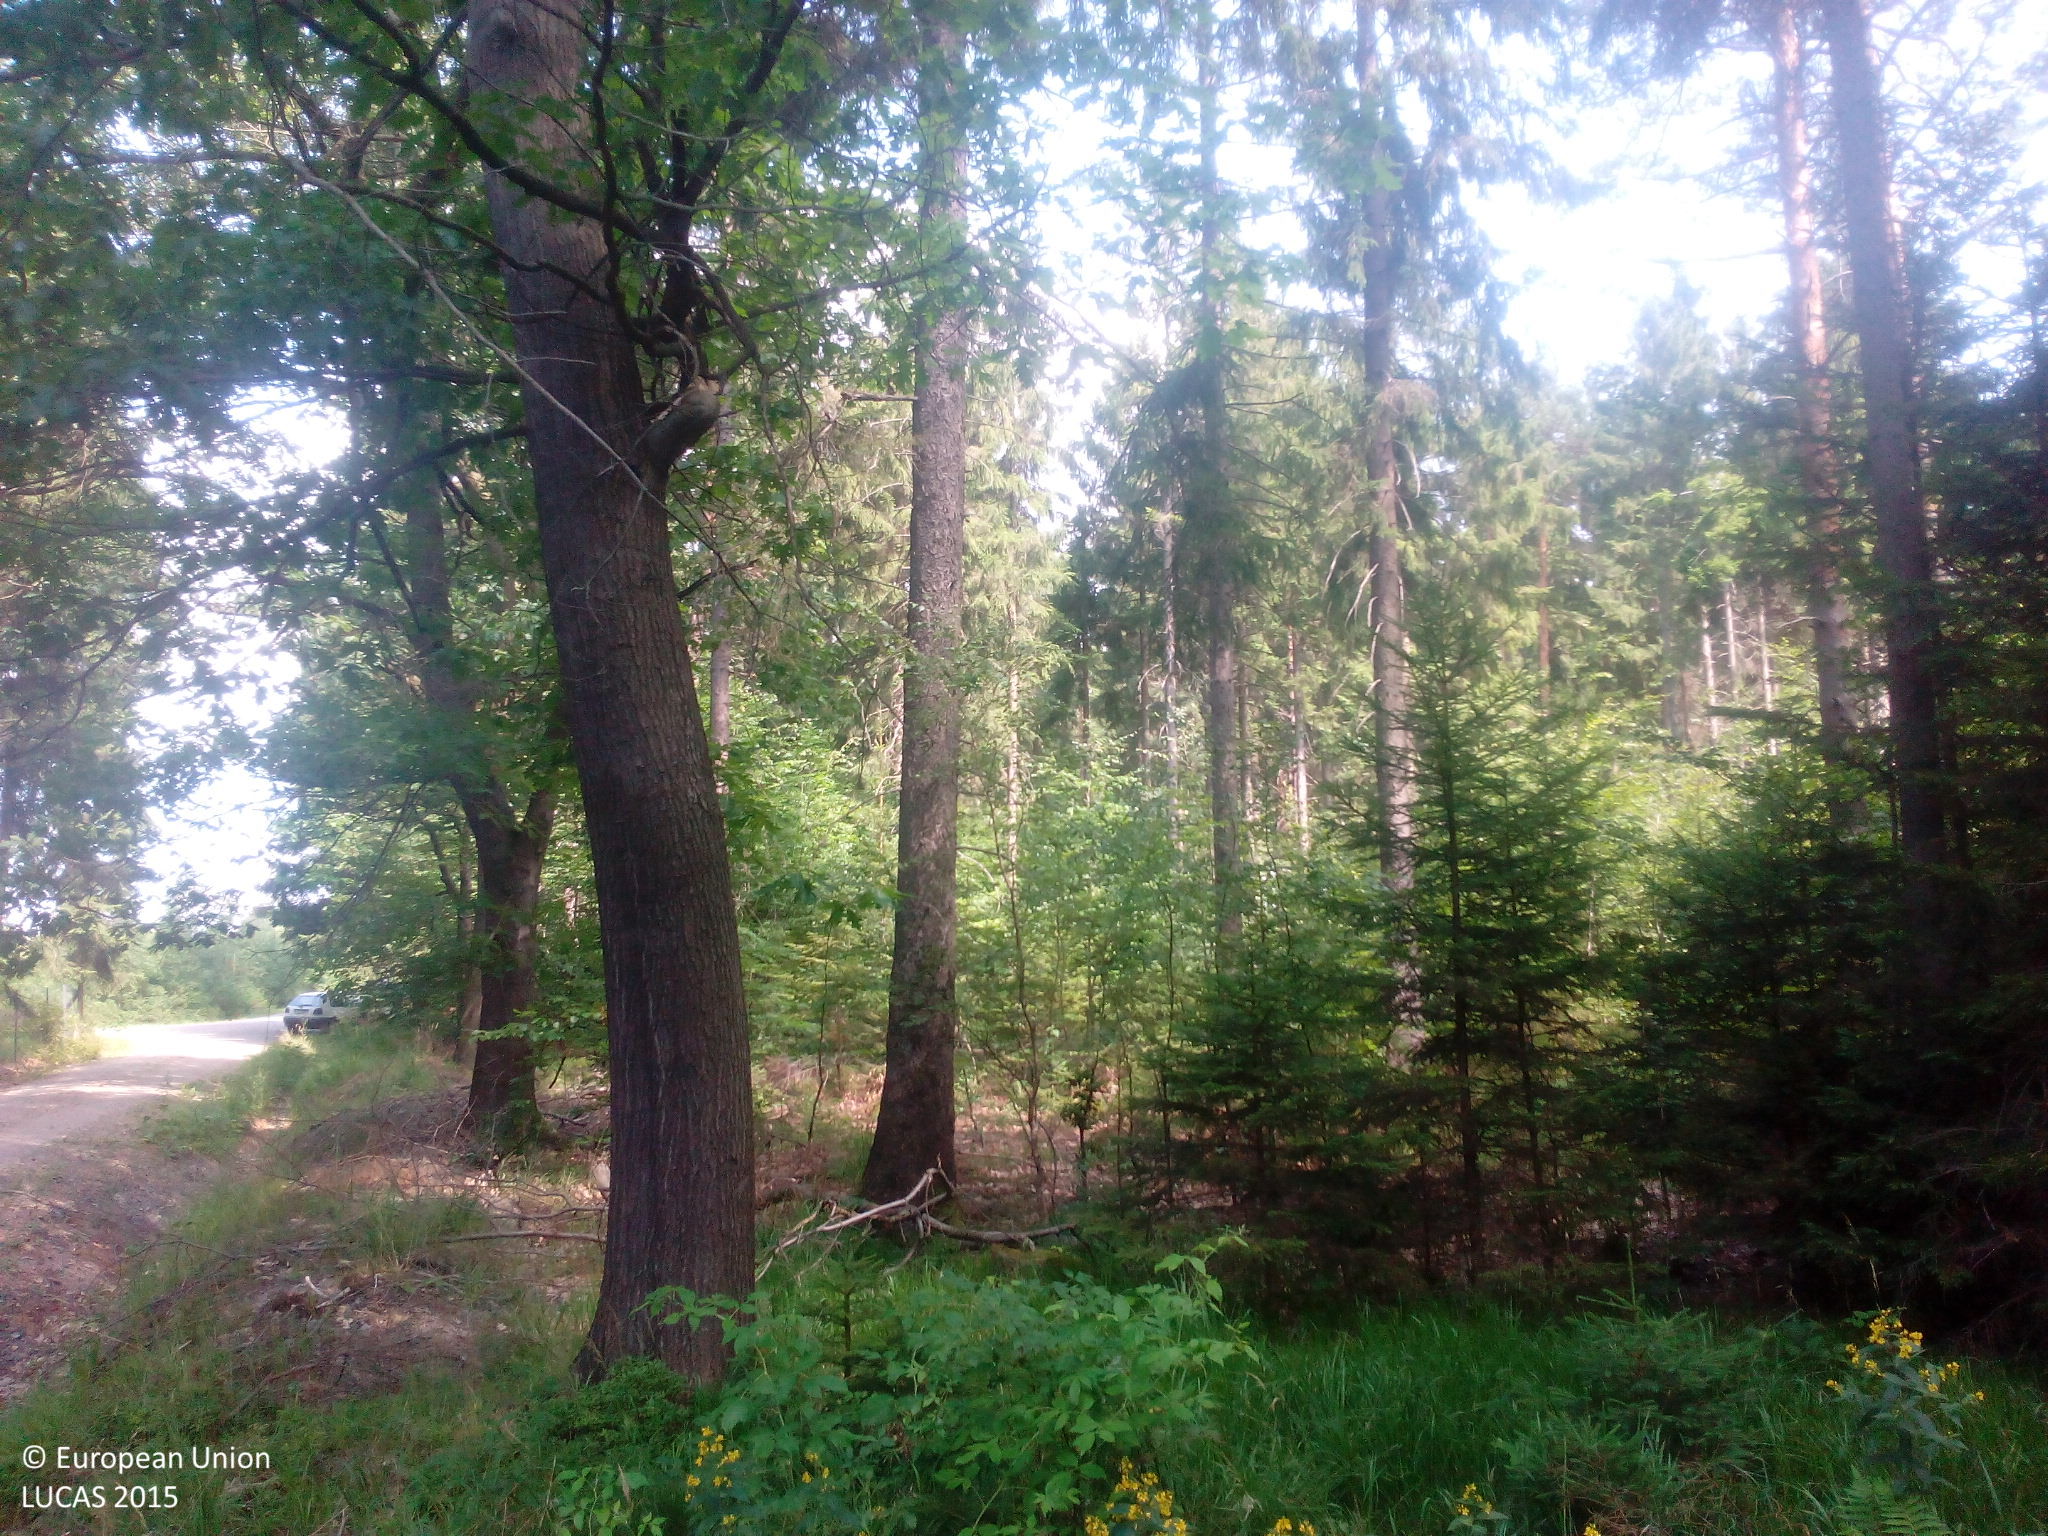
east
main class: Woodland
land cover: Spruce dominated mixed woodland
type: hemiboreal forest and nemoral coniferous forest and mixed broadleaved-coniferous forest
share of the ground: > 75 %
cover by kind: coniferous forest trees 70 %, broadleaved forest trees 30 %
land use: Forestry
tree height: > 5 m
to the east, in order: Spruce dominated mixed woodland; Ditches and canals; Paved roads, cycling and walking lanes; Ditches and canals; Spruce dominated mixed woodland; Spruce dominated coniferous woodland
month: July
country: DE
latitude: 50.9588
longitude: 13.4885
